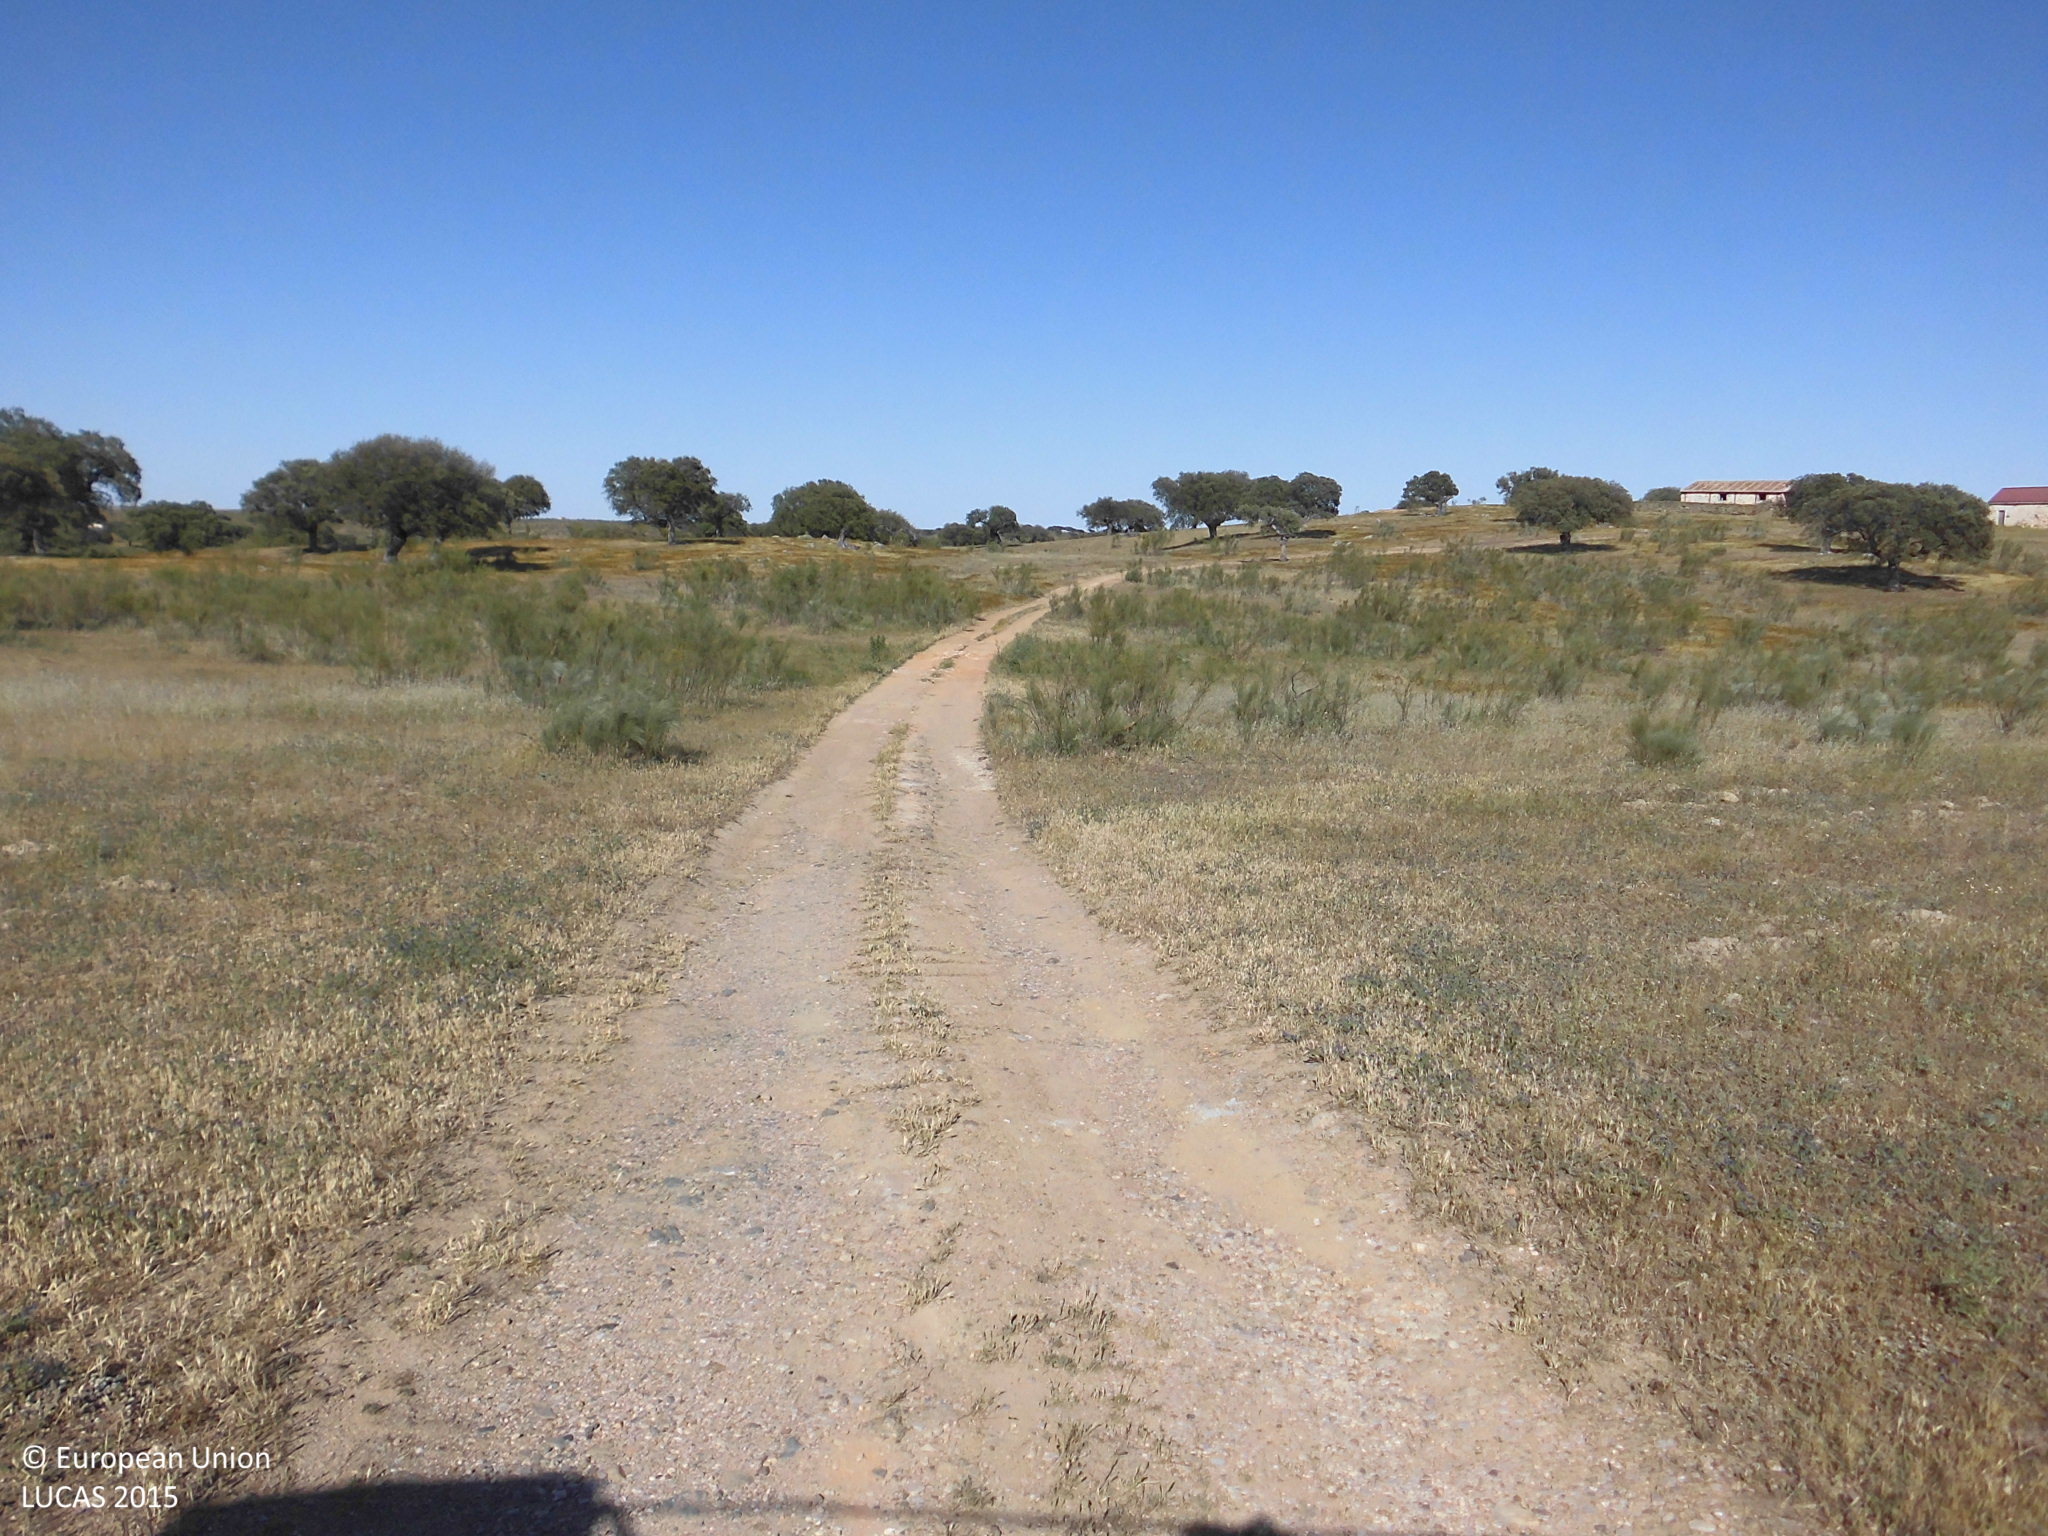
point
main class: Shrubland
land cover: Shrubland without tree cover
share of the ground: 10 - 25 %
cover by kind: herbaceous plants 80 %, shrubs 20 %
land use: Agriculture (excluding fallow land and kitchen gardens)
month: May
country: ES
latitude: 39.4796
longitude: -6.8538
